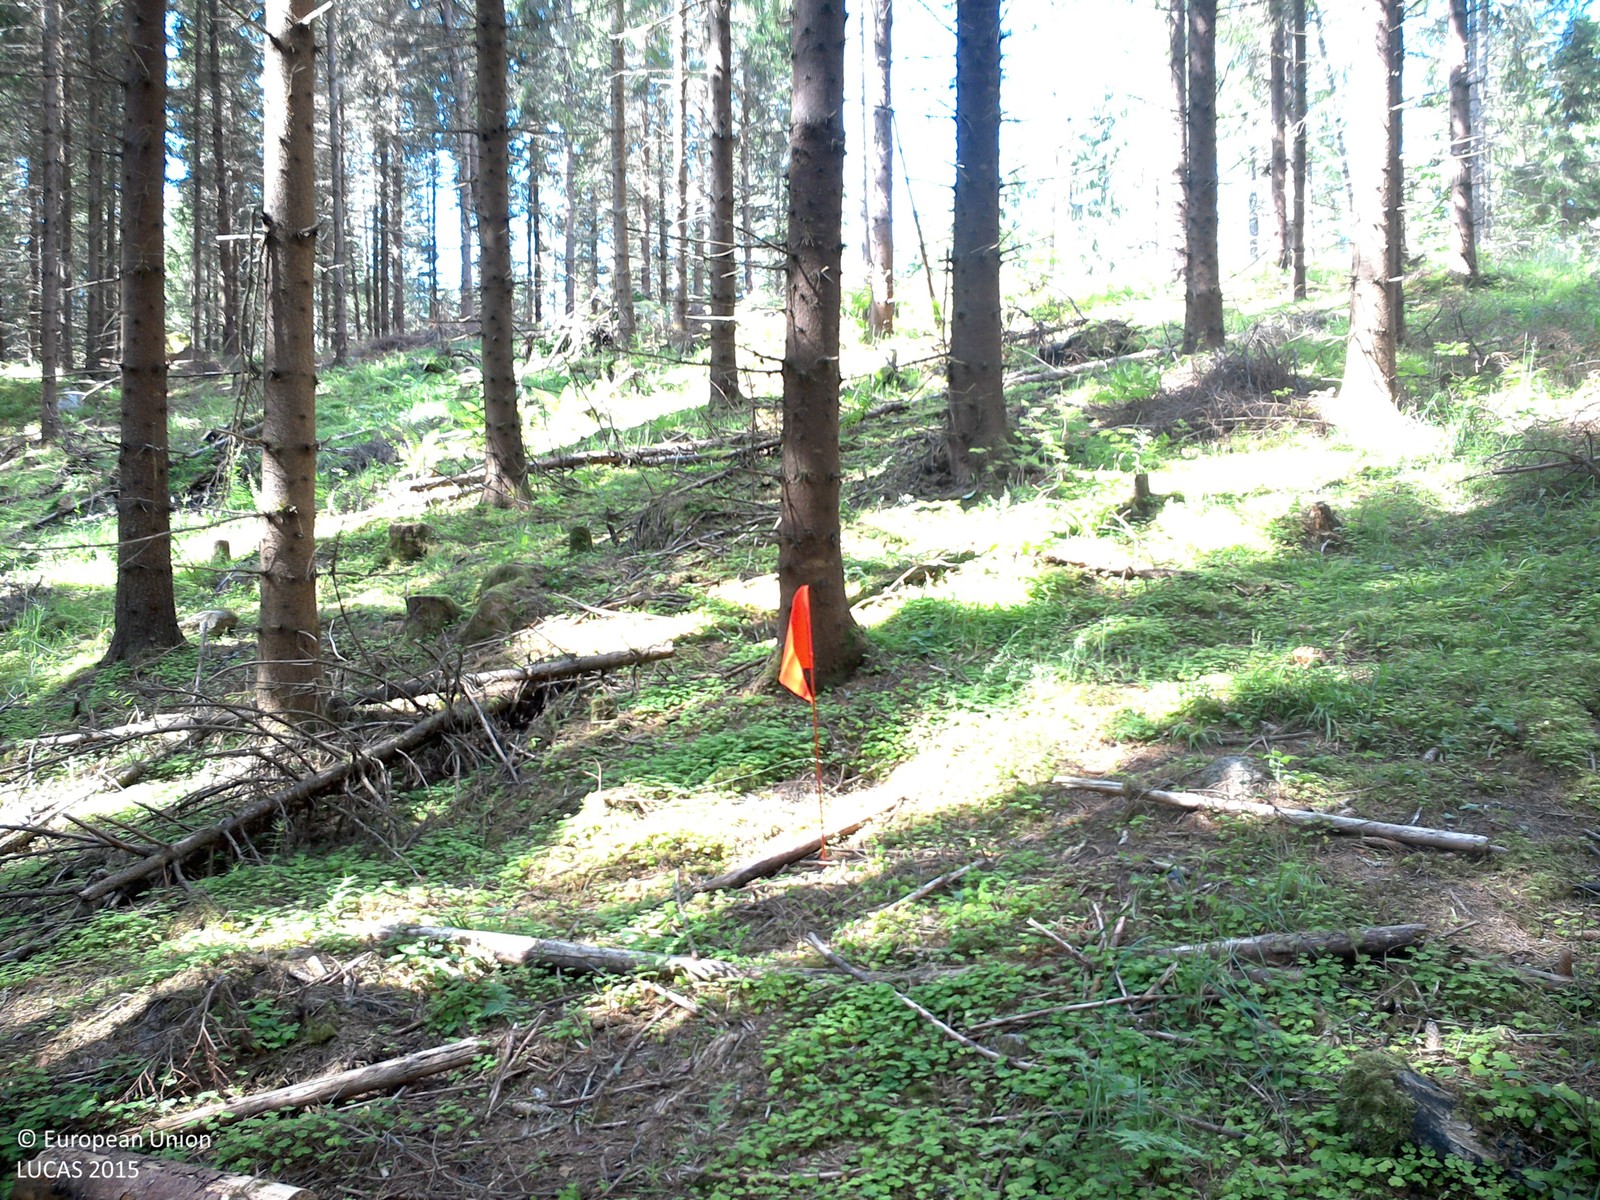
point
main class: Woodland
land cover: Spruce dominated coniferous woodland
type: boreal forest
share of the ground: 50 - 75 %
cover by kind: coniferous forest trees 60 %, herbaceous plants 20 %, lichens and mosses 20 %
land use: Forestry
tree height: > 5 m
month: July
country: SE
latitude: 58.0095
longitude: 14.7503
